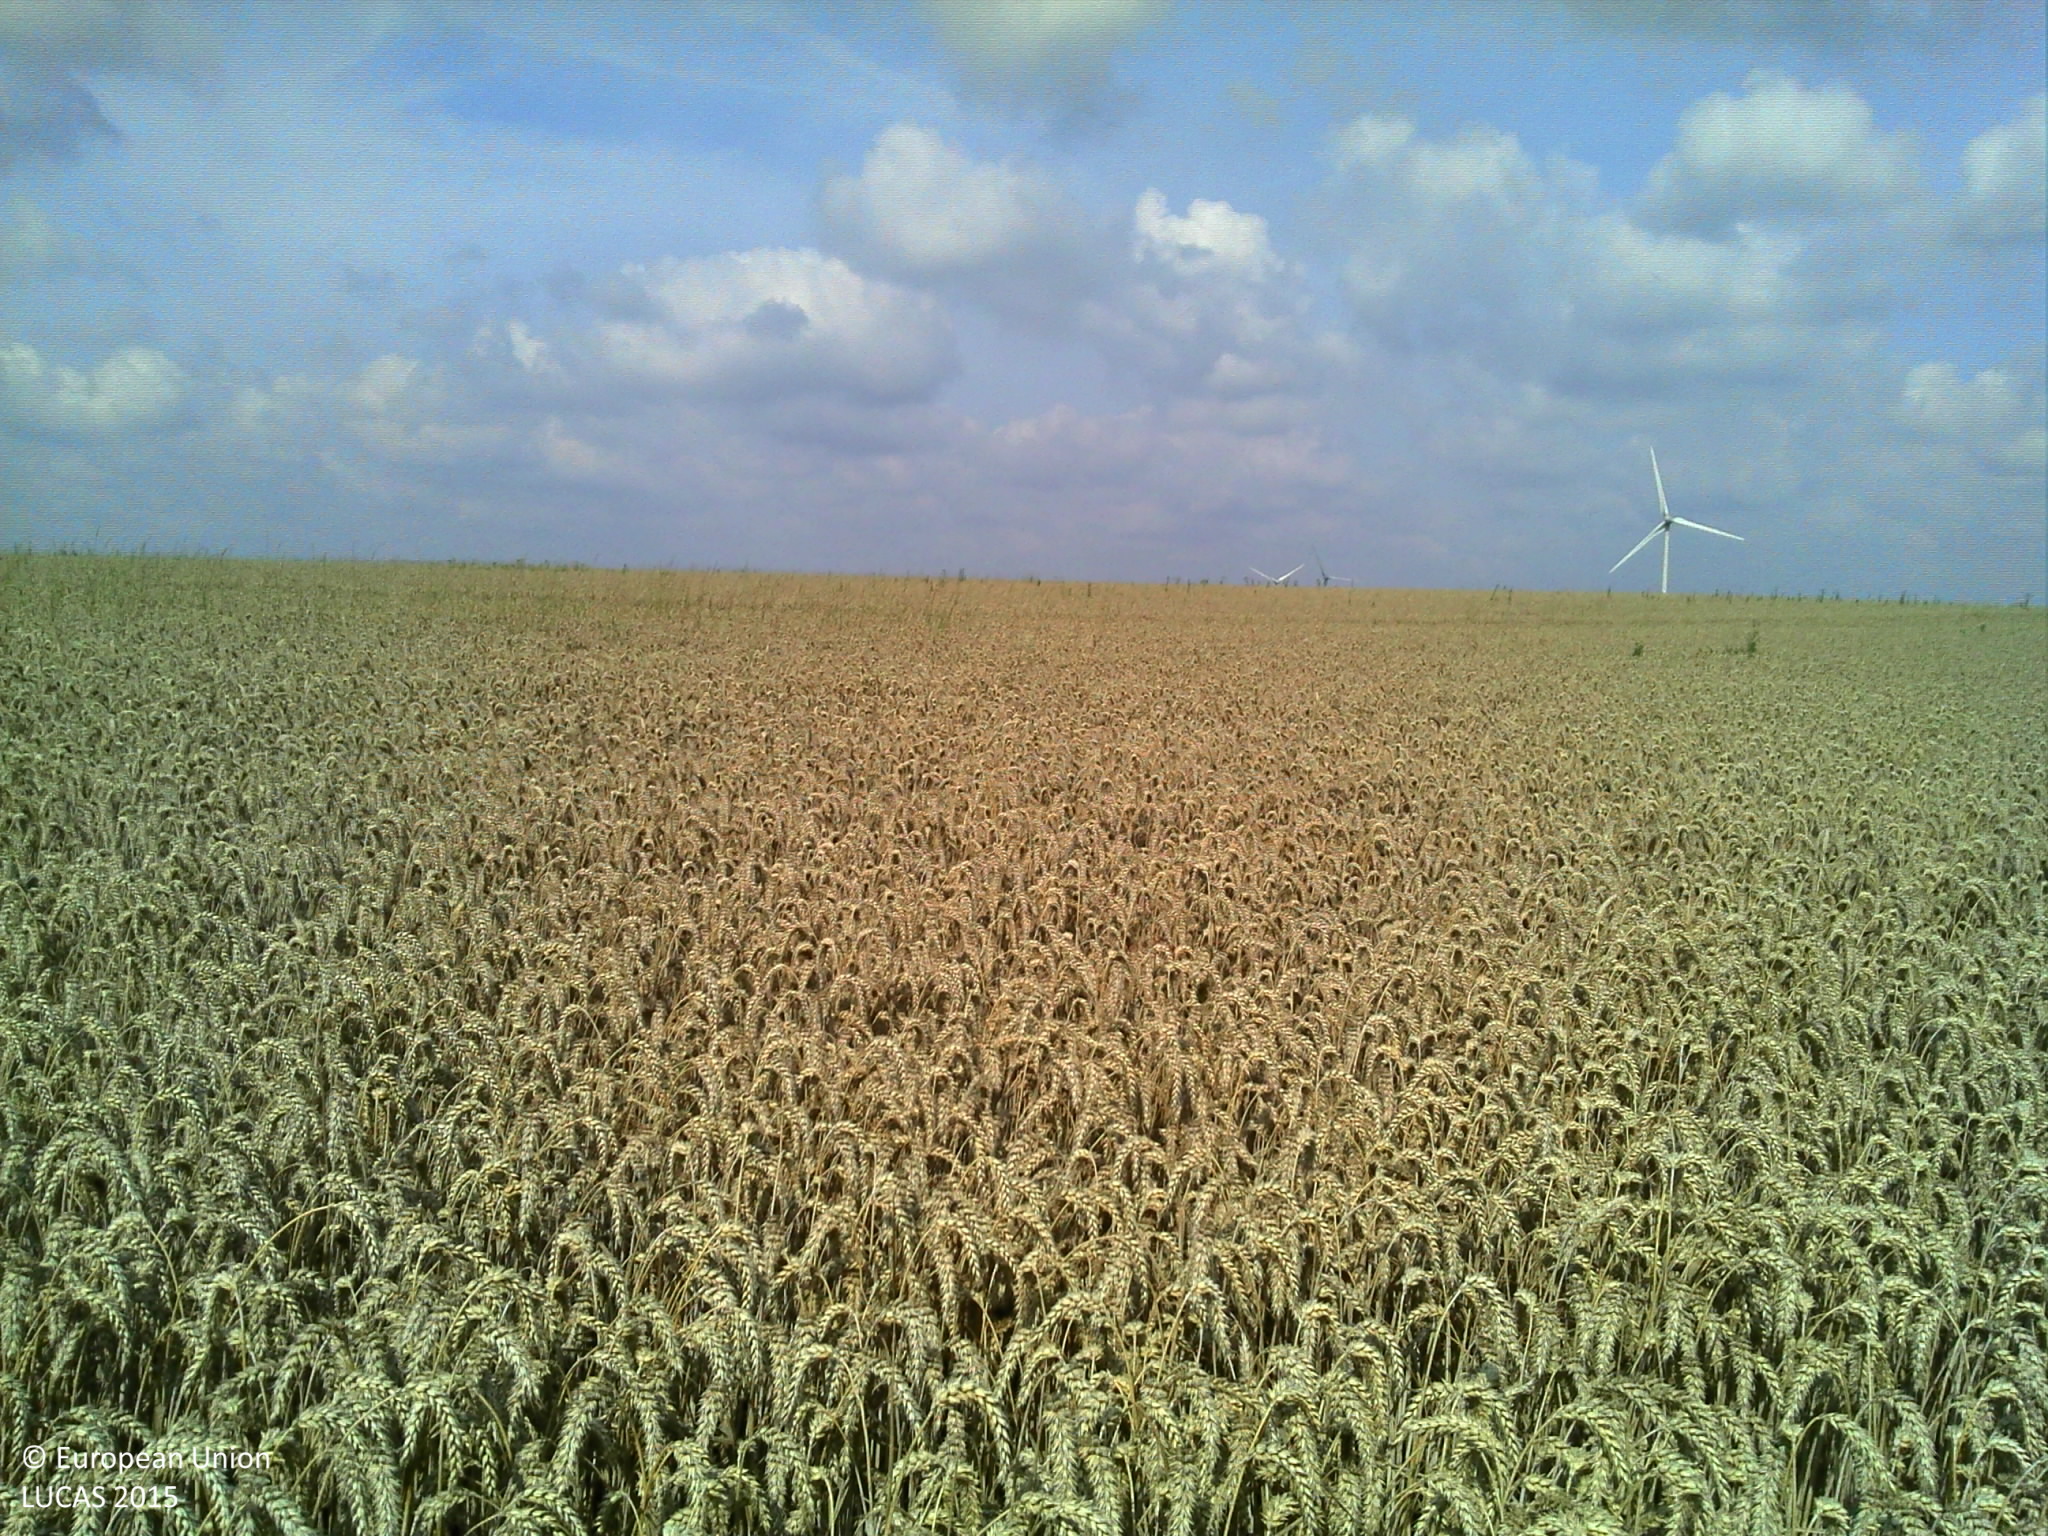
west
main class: Cropland
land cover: Common wheat
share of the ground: > 75 %
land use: Agriculture (excluding fallow land and kitchen gardens)
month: July
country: FR
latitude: 50.1001
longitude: 2.5081
